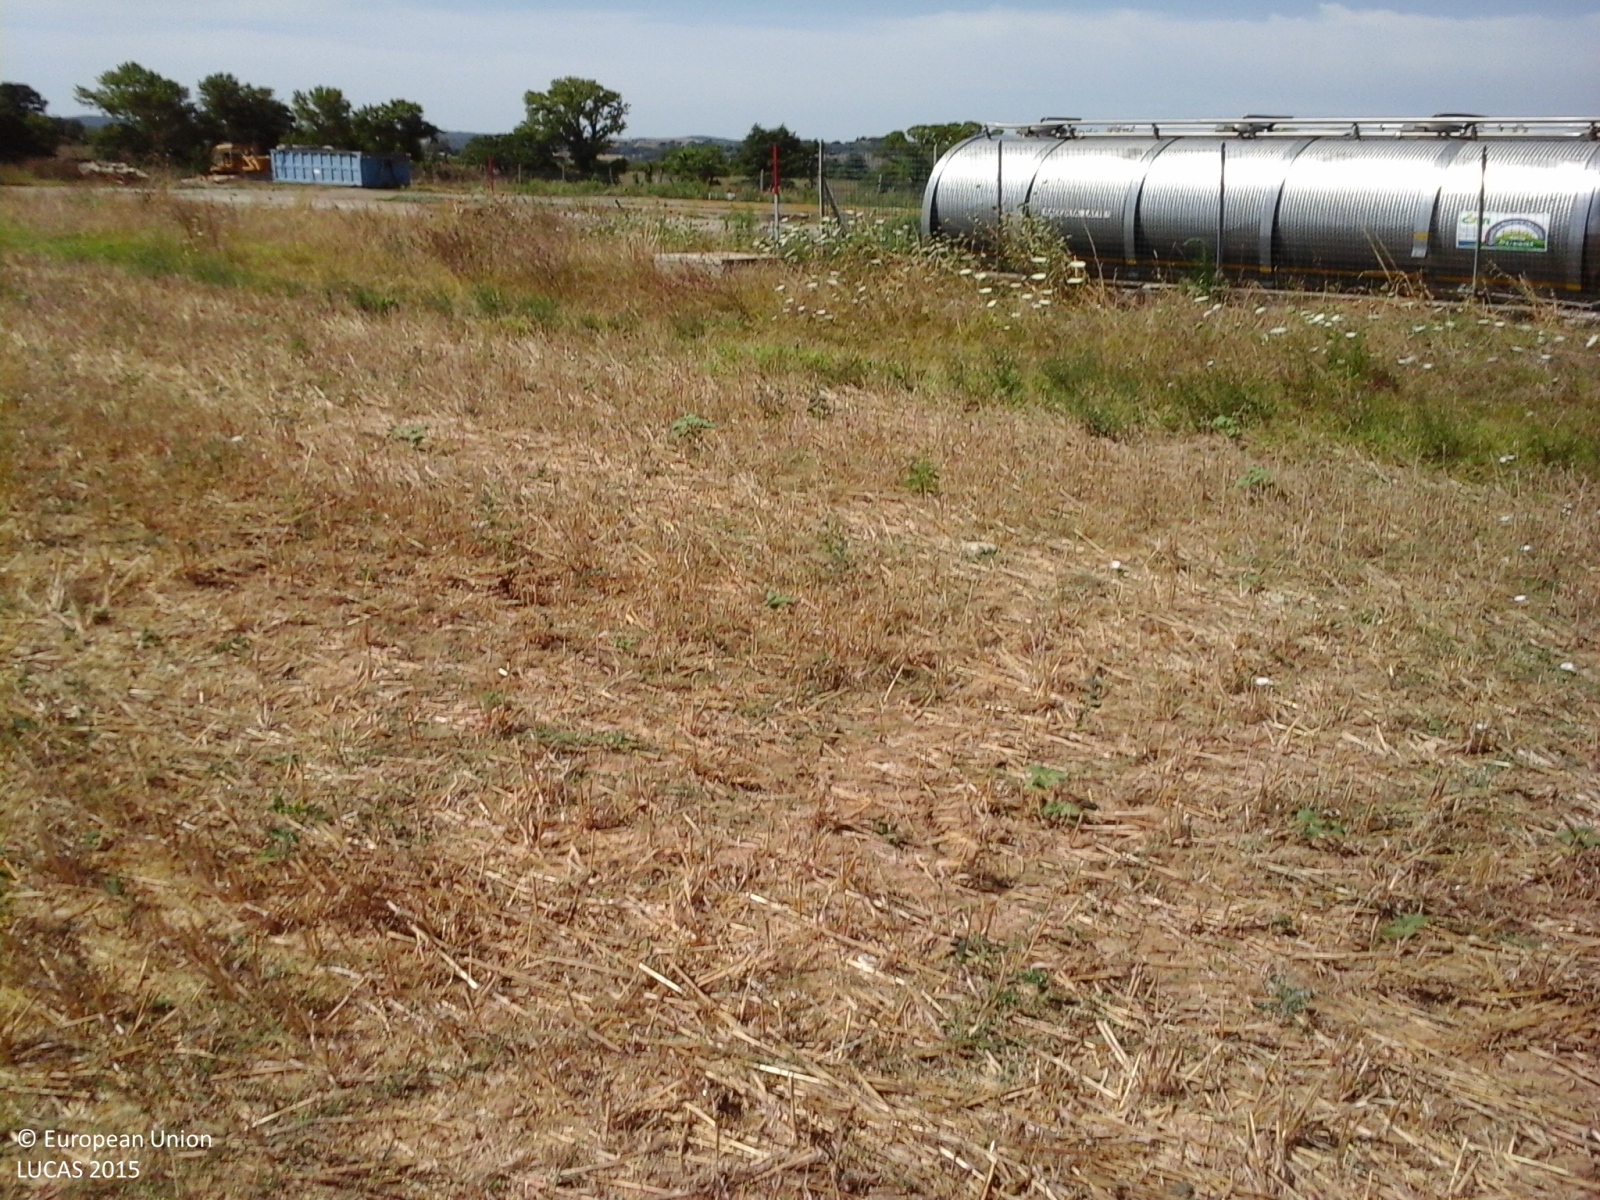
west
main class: Cropland
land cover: Barley
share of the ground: > 75 %
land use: Agriculture (excluding fallow land and kitchen gardens)
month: August
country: IT
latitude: 42.5354
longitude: 11.4439
